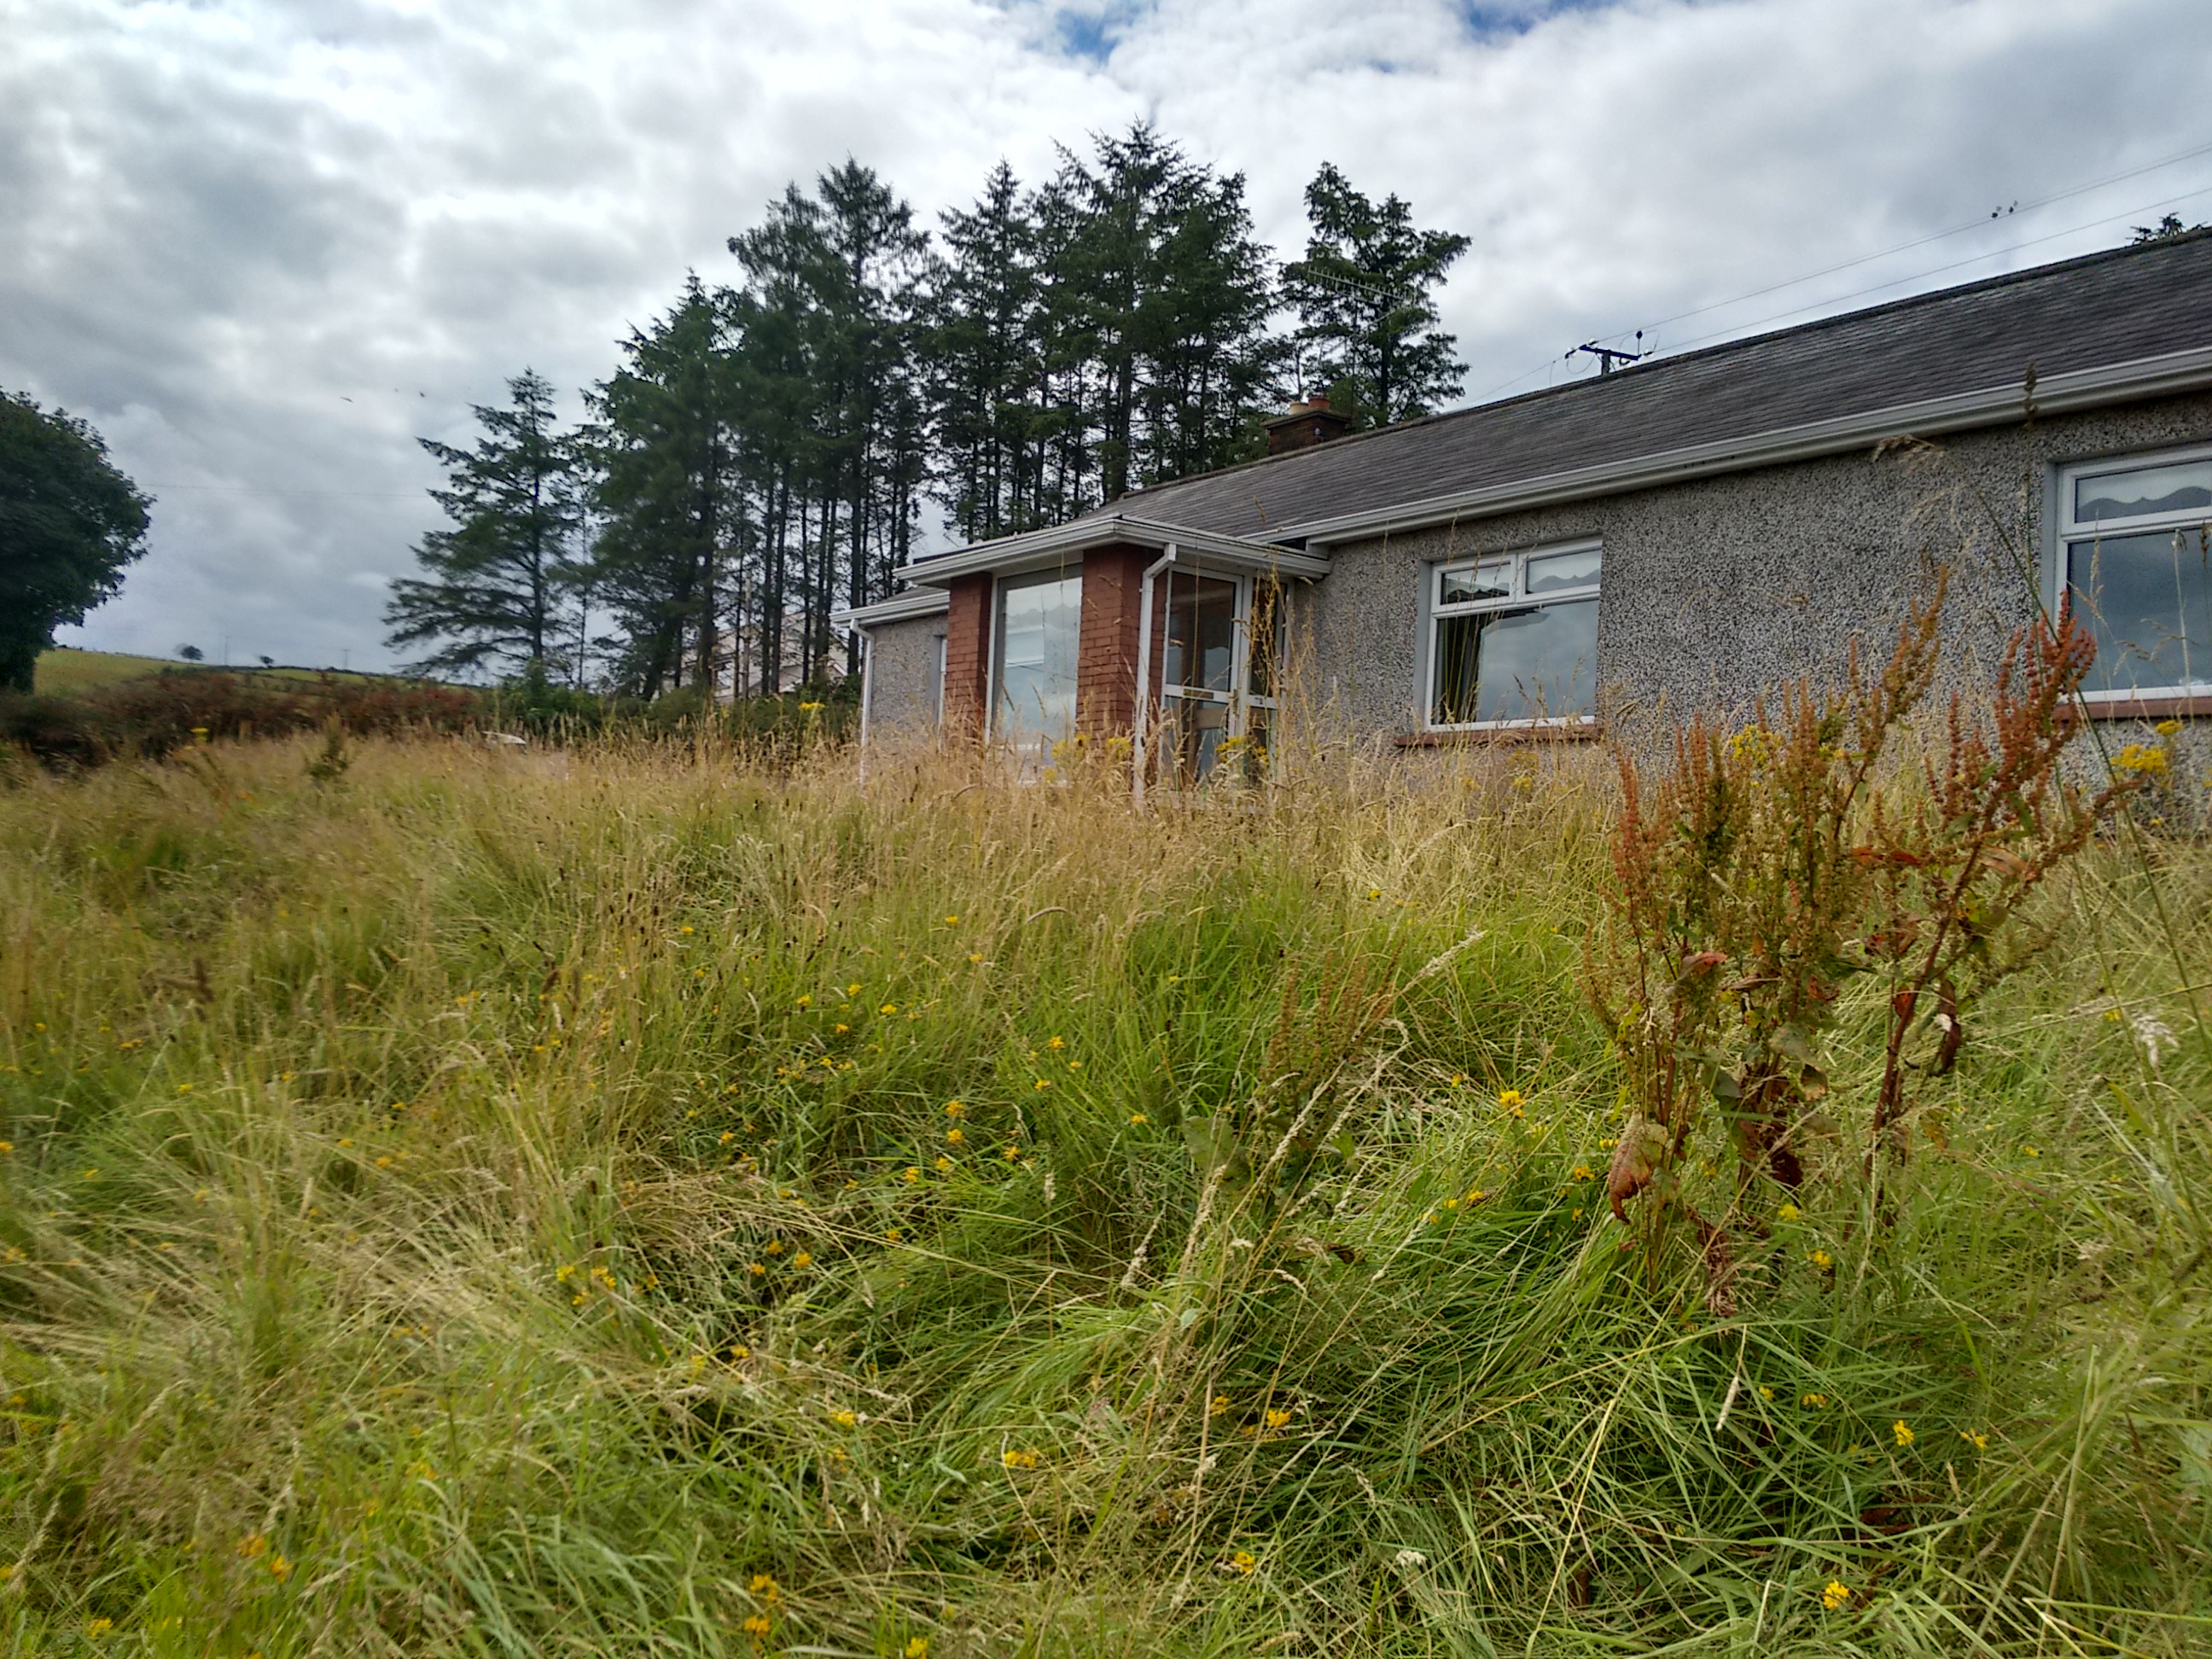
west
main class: Grassland
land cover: Grassland without tree/shrub cover
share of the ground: > 75 %
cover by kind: herbaceous plants 100 %
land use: Agriculture (excluding fallow land and kitchen gardens)
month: August
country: GB
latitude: 54.5593
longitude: -6.8830
